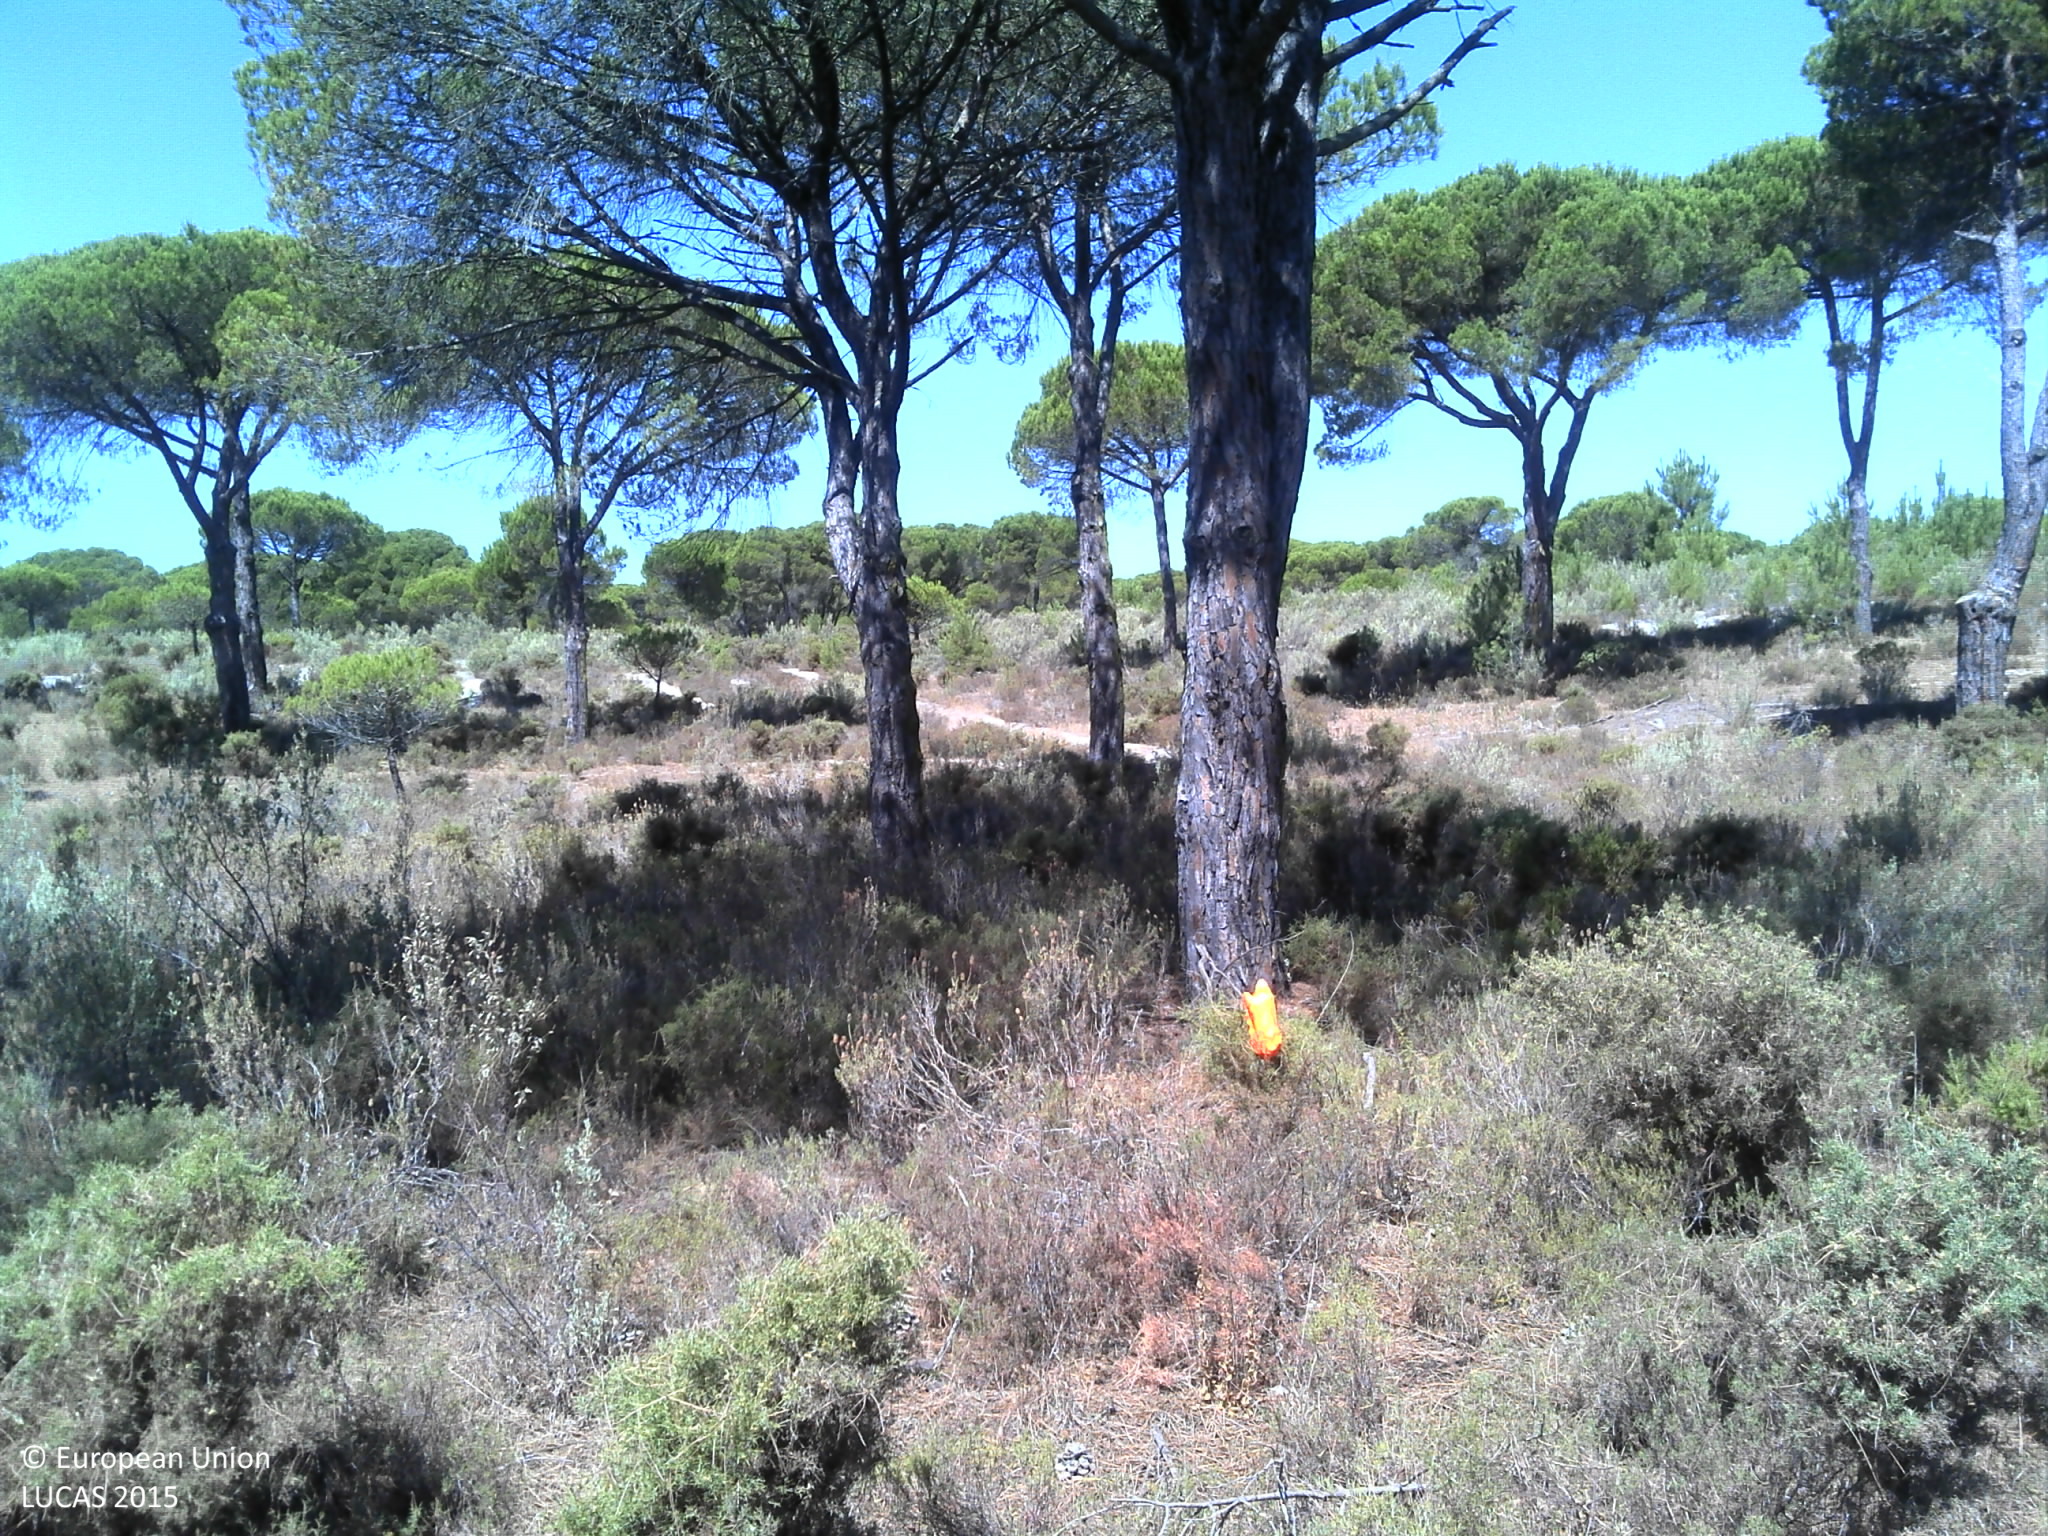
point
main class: Woodland
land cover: Pine dominated coniferous woodland
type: coniferous forest of the mediterranean region
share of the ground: 50 - 75 %
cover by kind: coniferous forest trees 60 %, shrubs 20 %, unconsolidated bare surface 20 %
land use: Forestry
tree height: > 5 m
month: July
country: PT
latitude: 38.3019
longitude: -8.7052
